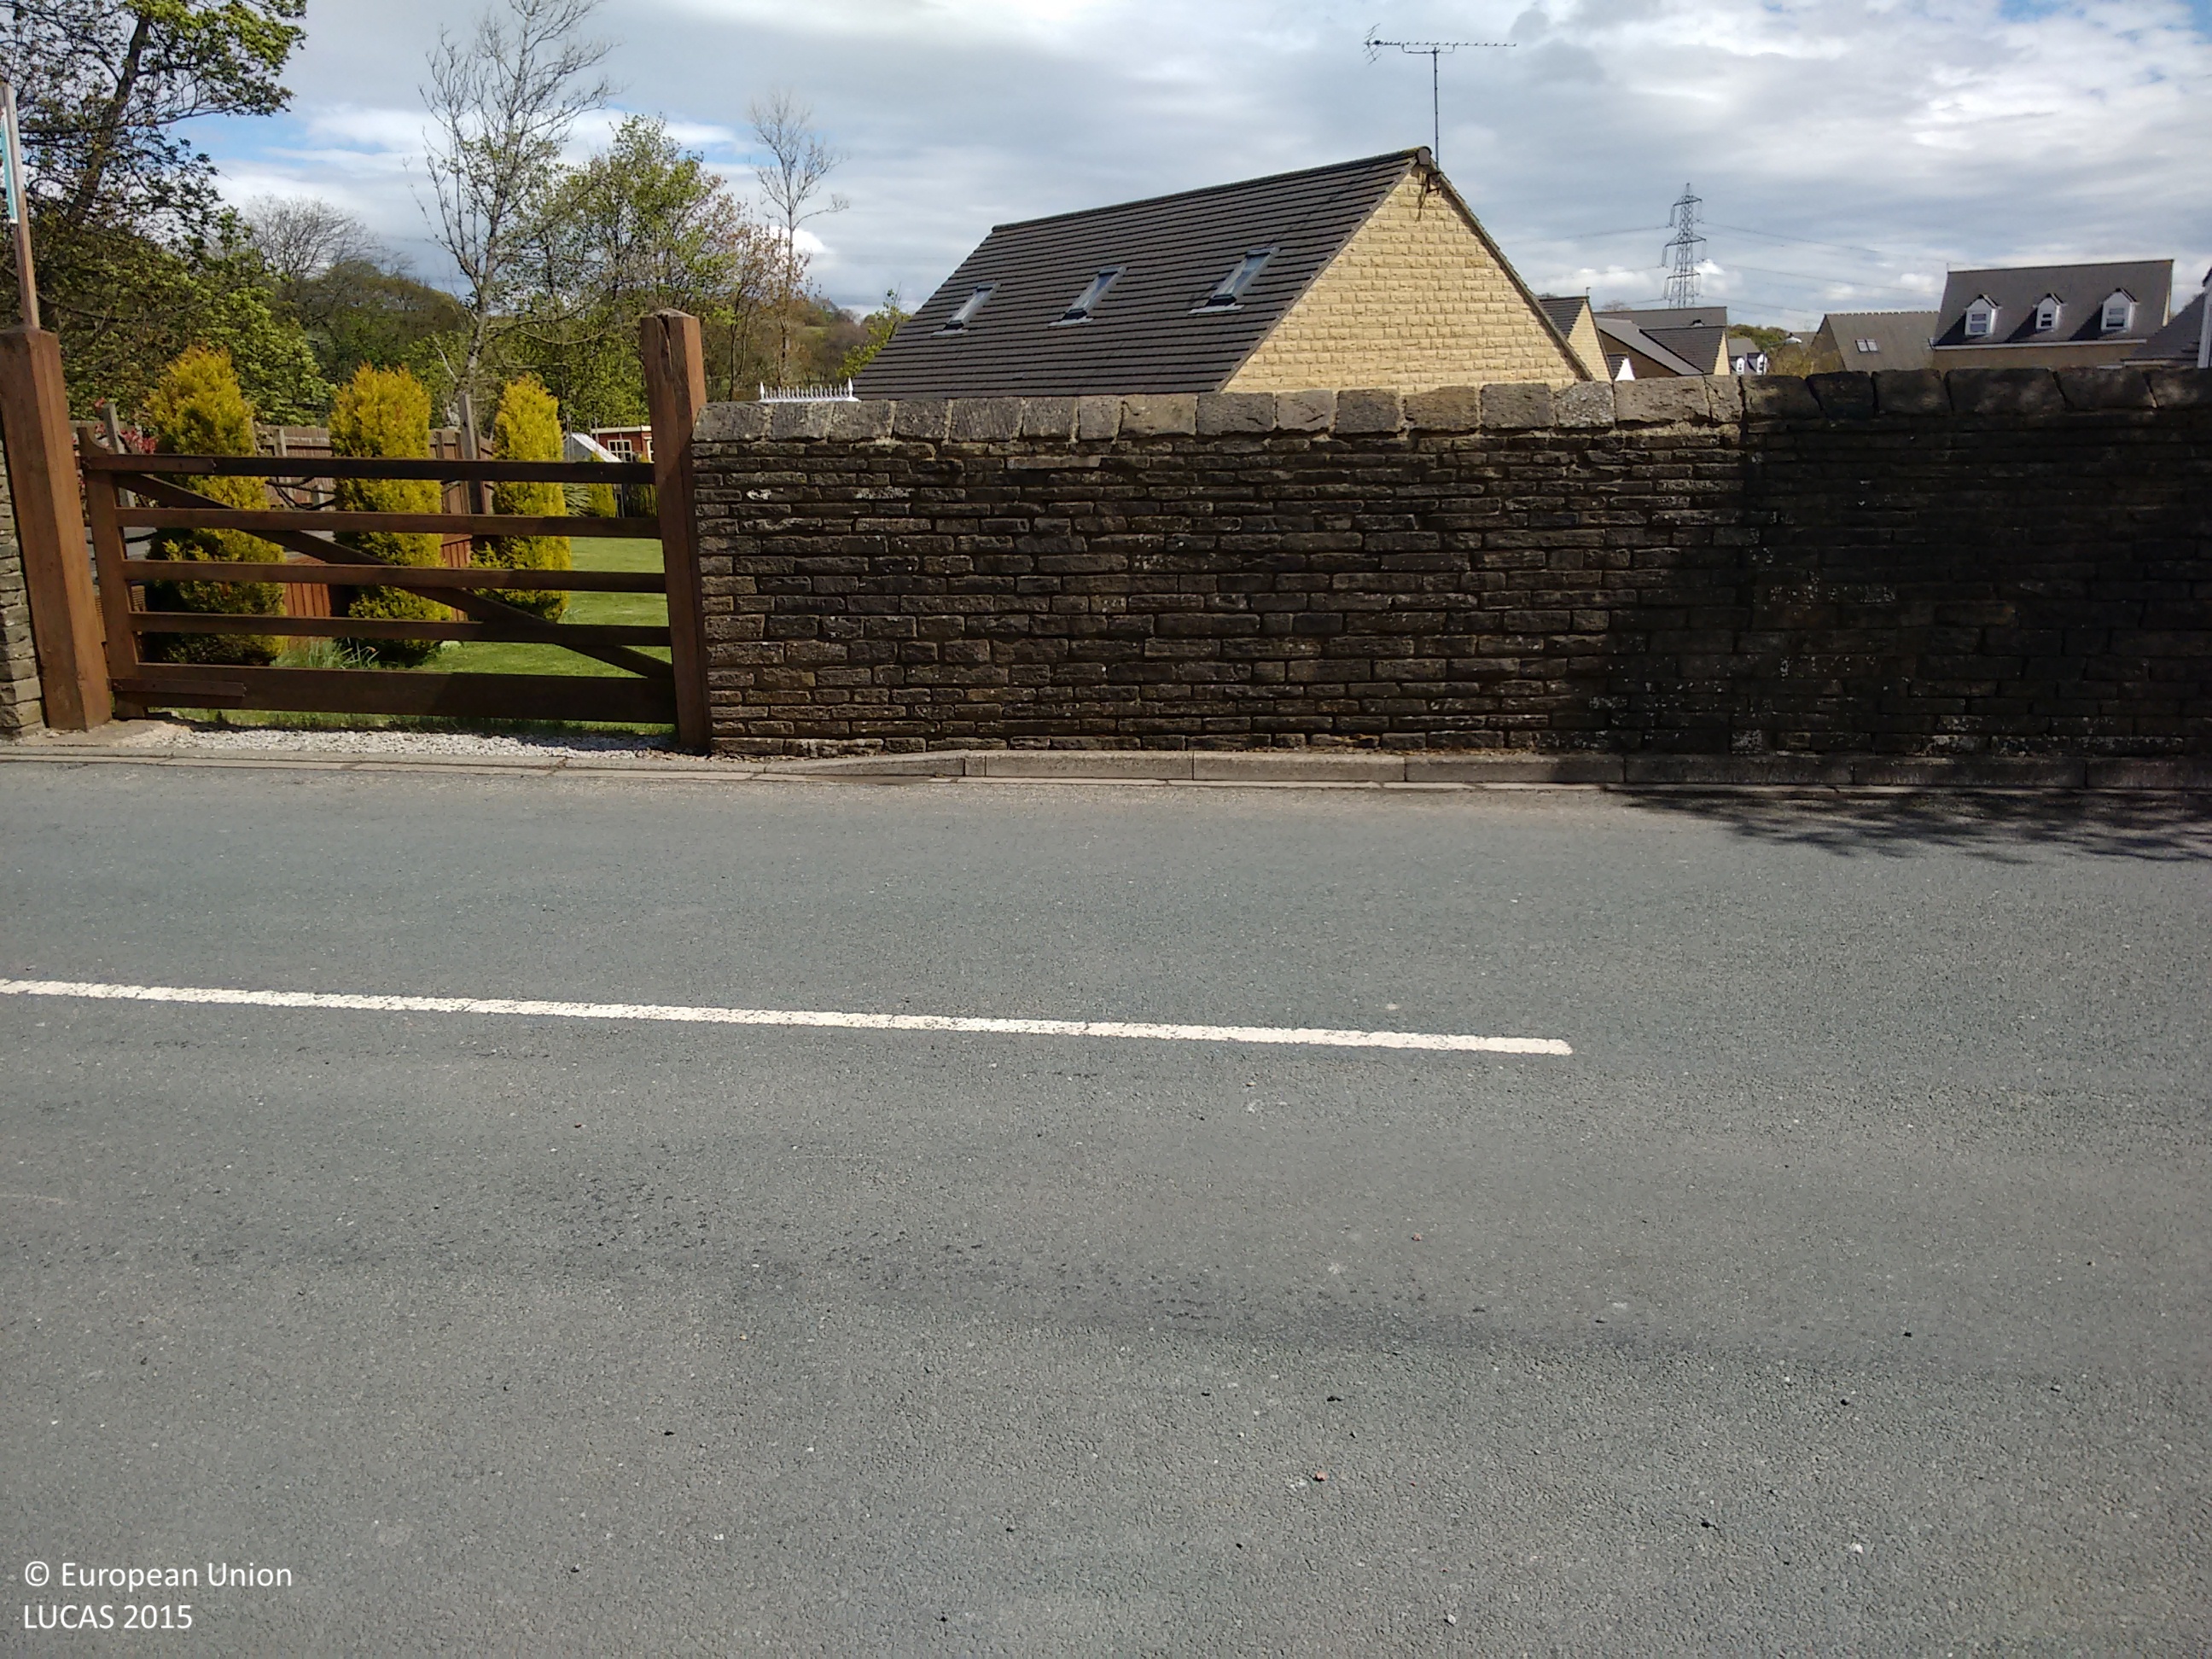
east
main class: Grassland
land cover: Grassland without tree/shrub cover
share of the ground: > 75 %
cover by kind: herbaceous plants 100 %
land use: Agriculture (excluding fallow land and kitchen gardens)
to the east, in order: Grassland without tree/shrub cover; Dry stone walls; Electric lines; Tracks; Paved roads, cycling and walking lanes; Tracks; Artificial constructions in urban areas
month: May
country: GB
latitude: 53.7462
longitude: -1.8367
